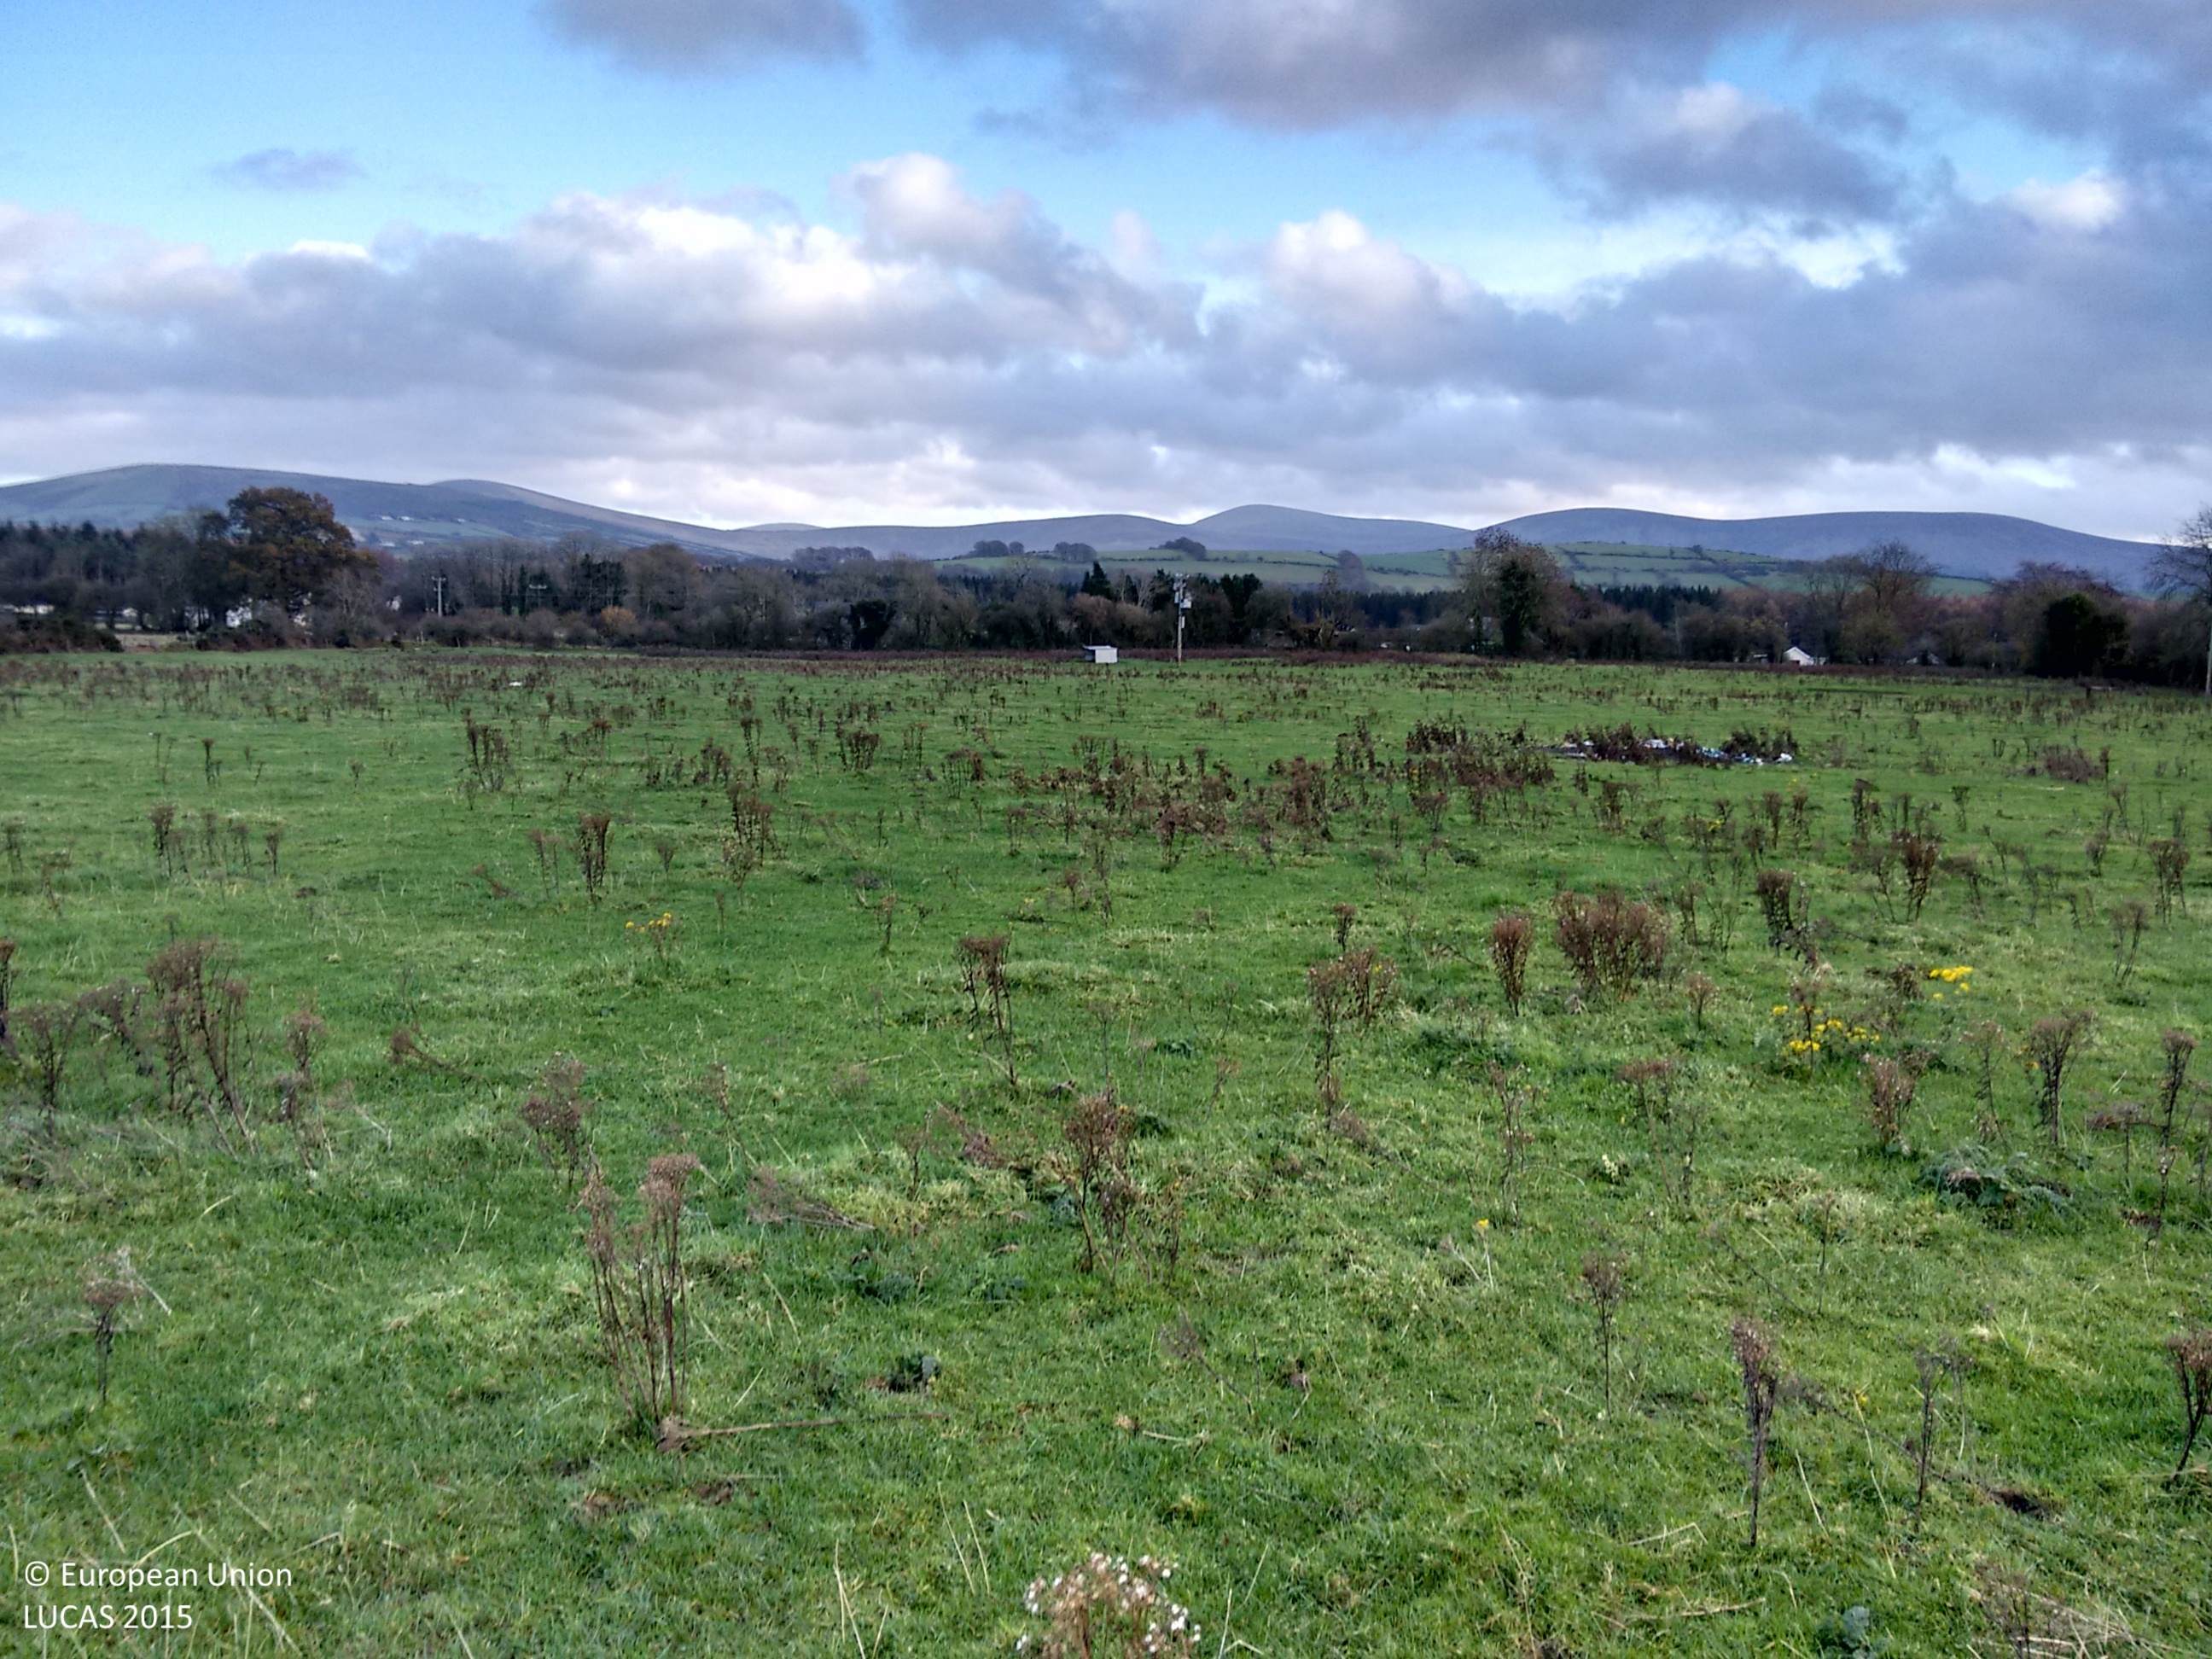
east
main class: Grassland
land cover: Grassland without tree/shrub cover
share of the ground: > 75 %
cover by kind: herbaceous plants 100 %
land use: Agriculture (excluding fallow land and kitchen gardens)
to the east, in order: Grassland without tree/shrub cover; Fences; Ditches and canals; Abandoned hedges; Fences; Grassland without tree/shrub cover; Abandoned hedges
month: November
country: IE
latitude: 53.1504
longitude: -6.5619
